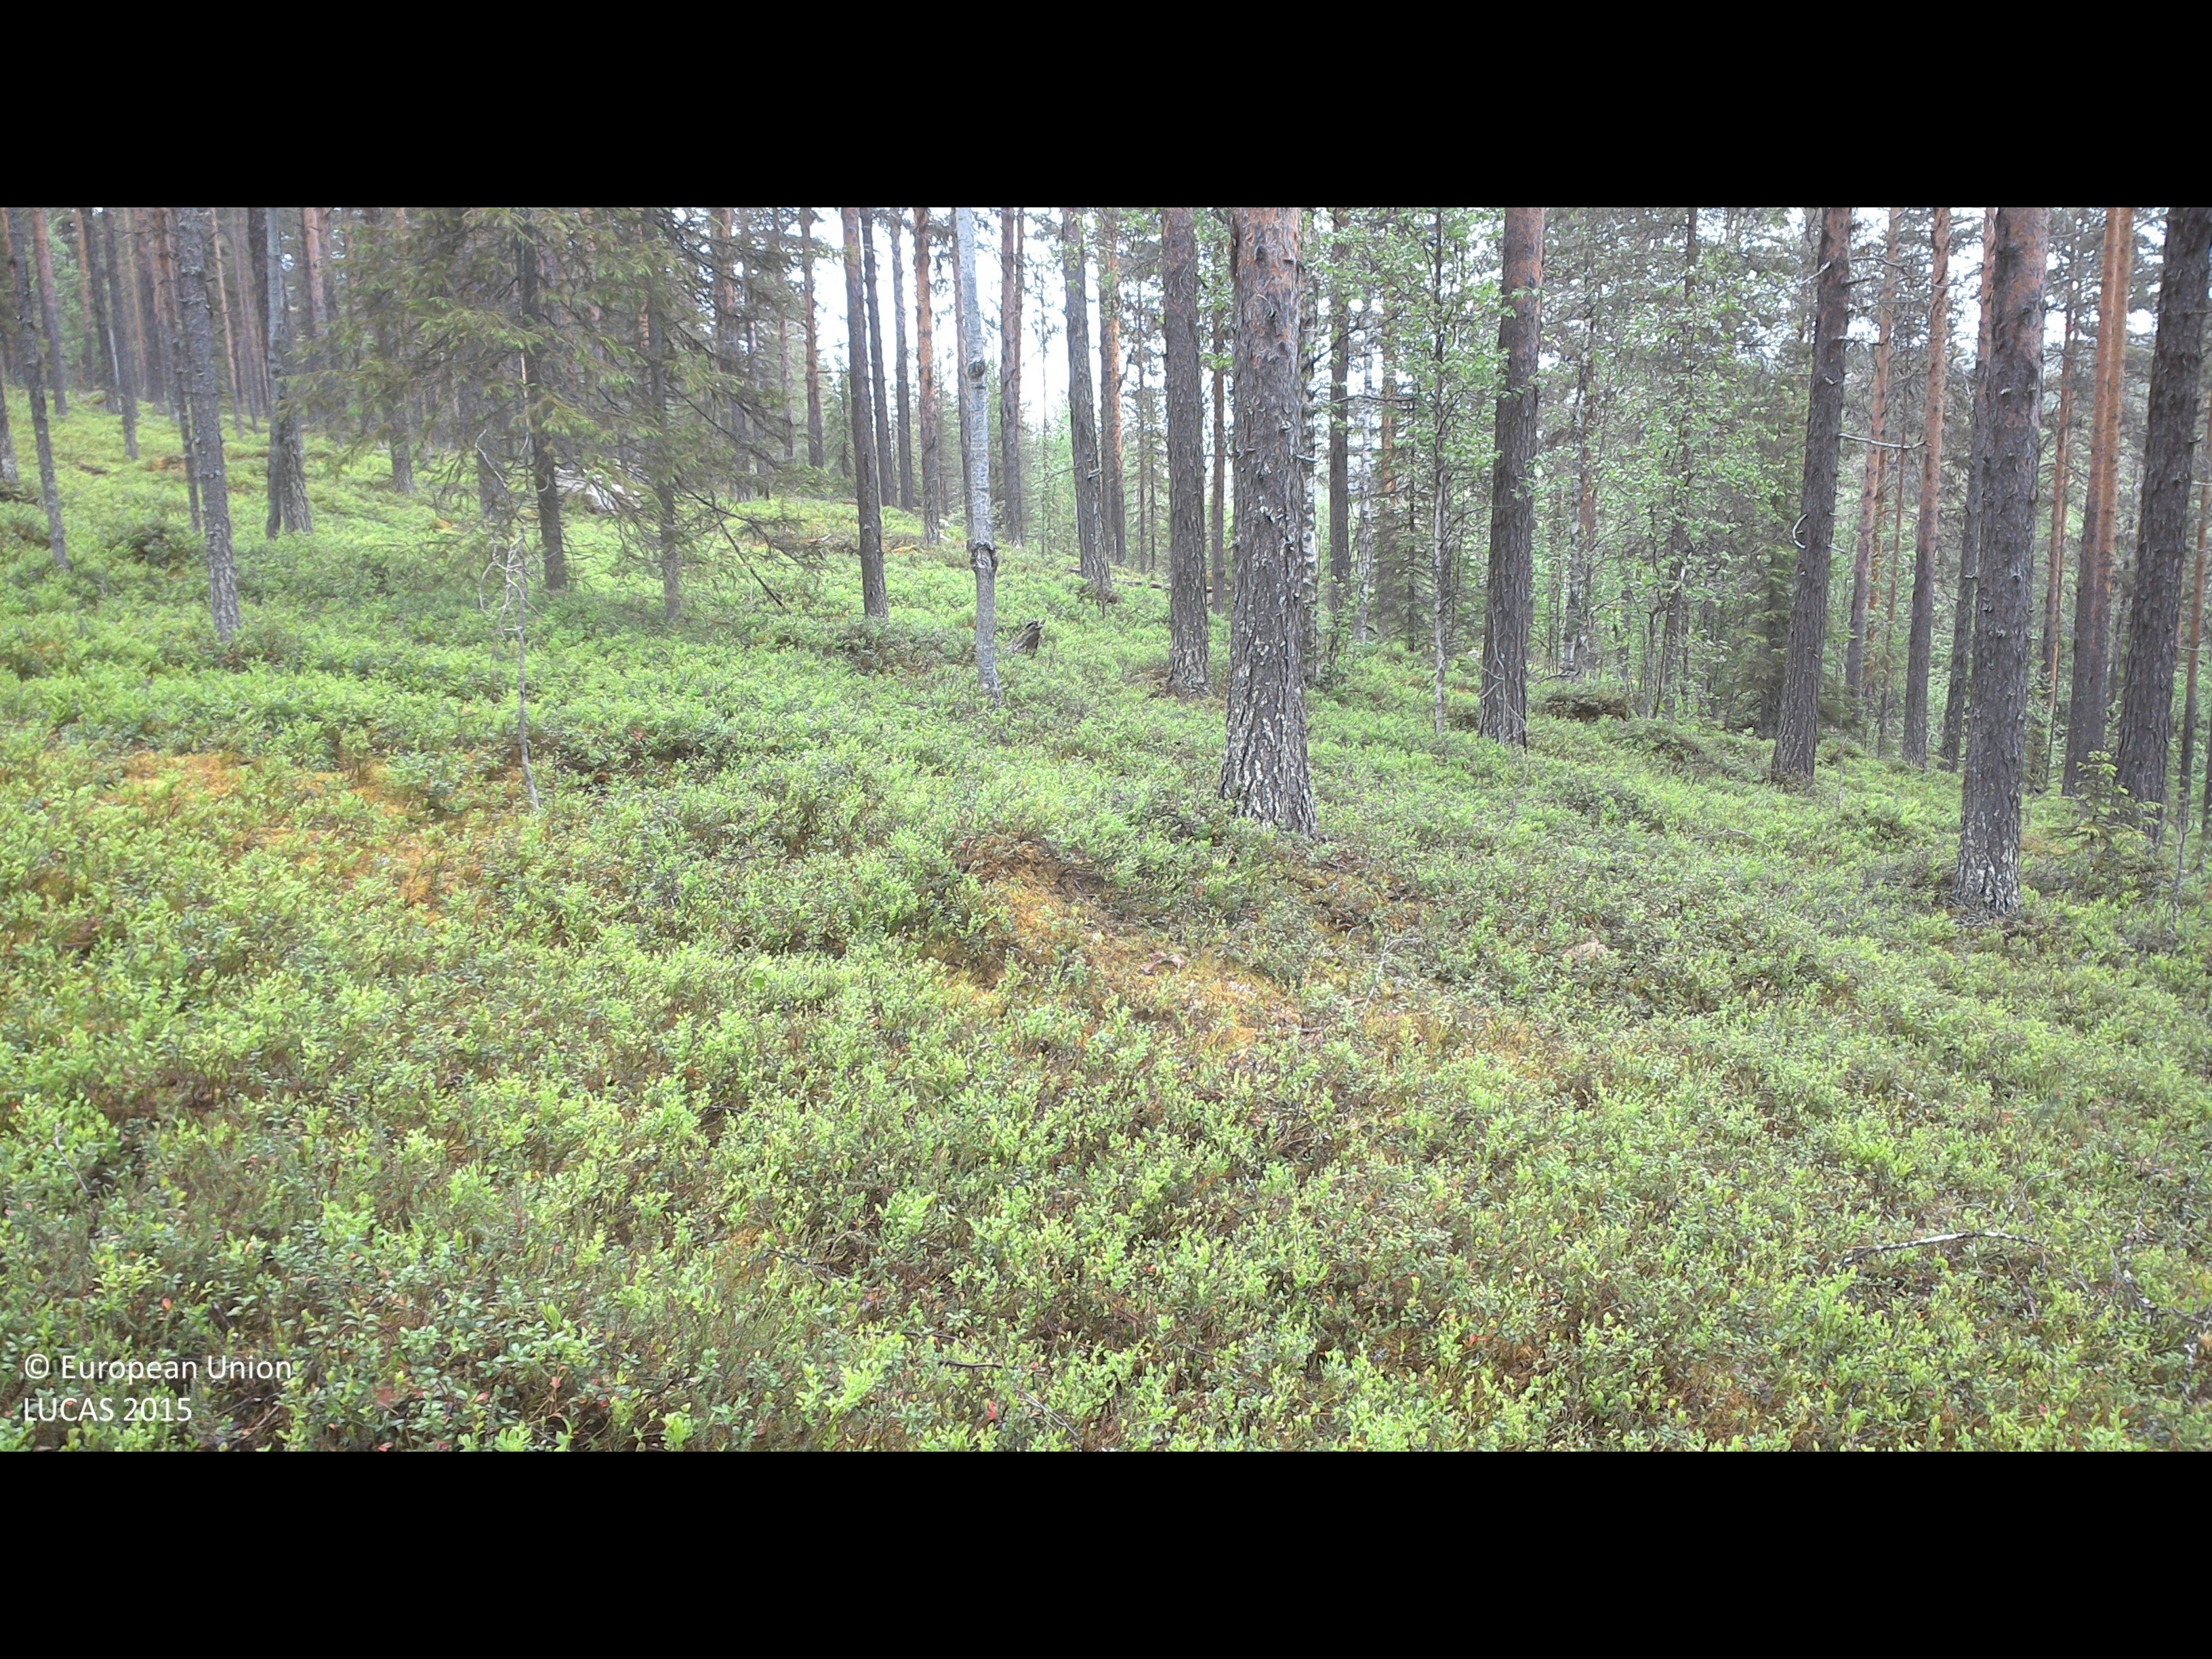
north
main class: Woodland
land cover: Pine dominated coniferous woodland
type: boreal forest
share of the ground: 25 - 50 %
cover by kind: shrubs 70 %, coniferous forest trees 30 %
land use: Forestry
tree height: > 5 m
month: June
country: SE
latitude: 66.8101
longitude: 22.6449
